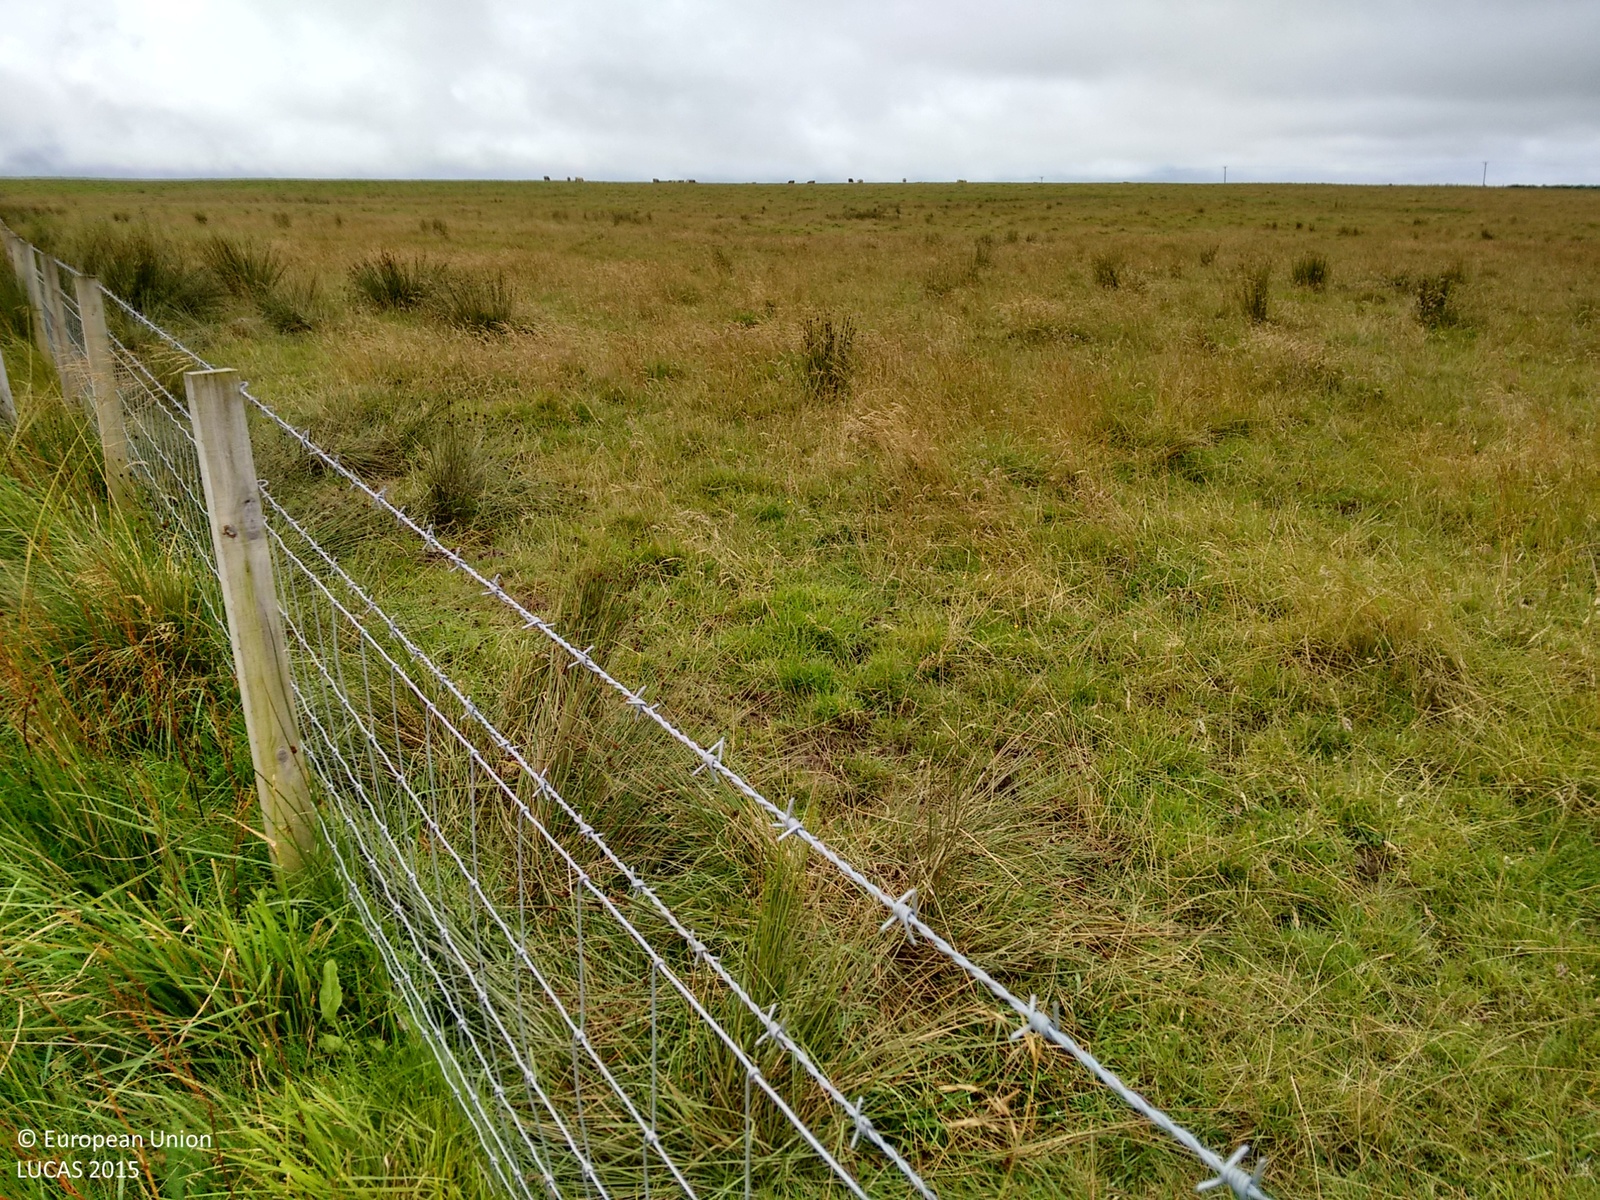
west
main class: Grassland
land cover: Grassland without tree/shrub cover
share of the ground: > 75 %
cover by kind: herbaceous plants 100 %
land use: Agriculture (excluding fallow land and kitchen gardens)
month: August
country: GB
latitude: 58.5264
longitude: -3.2655
